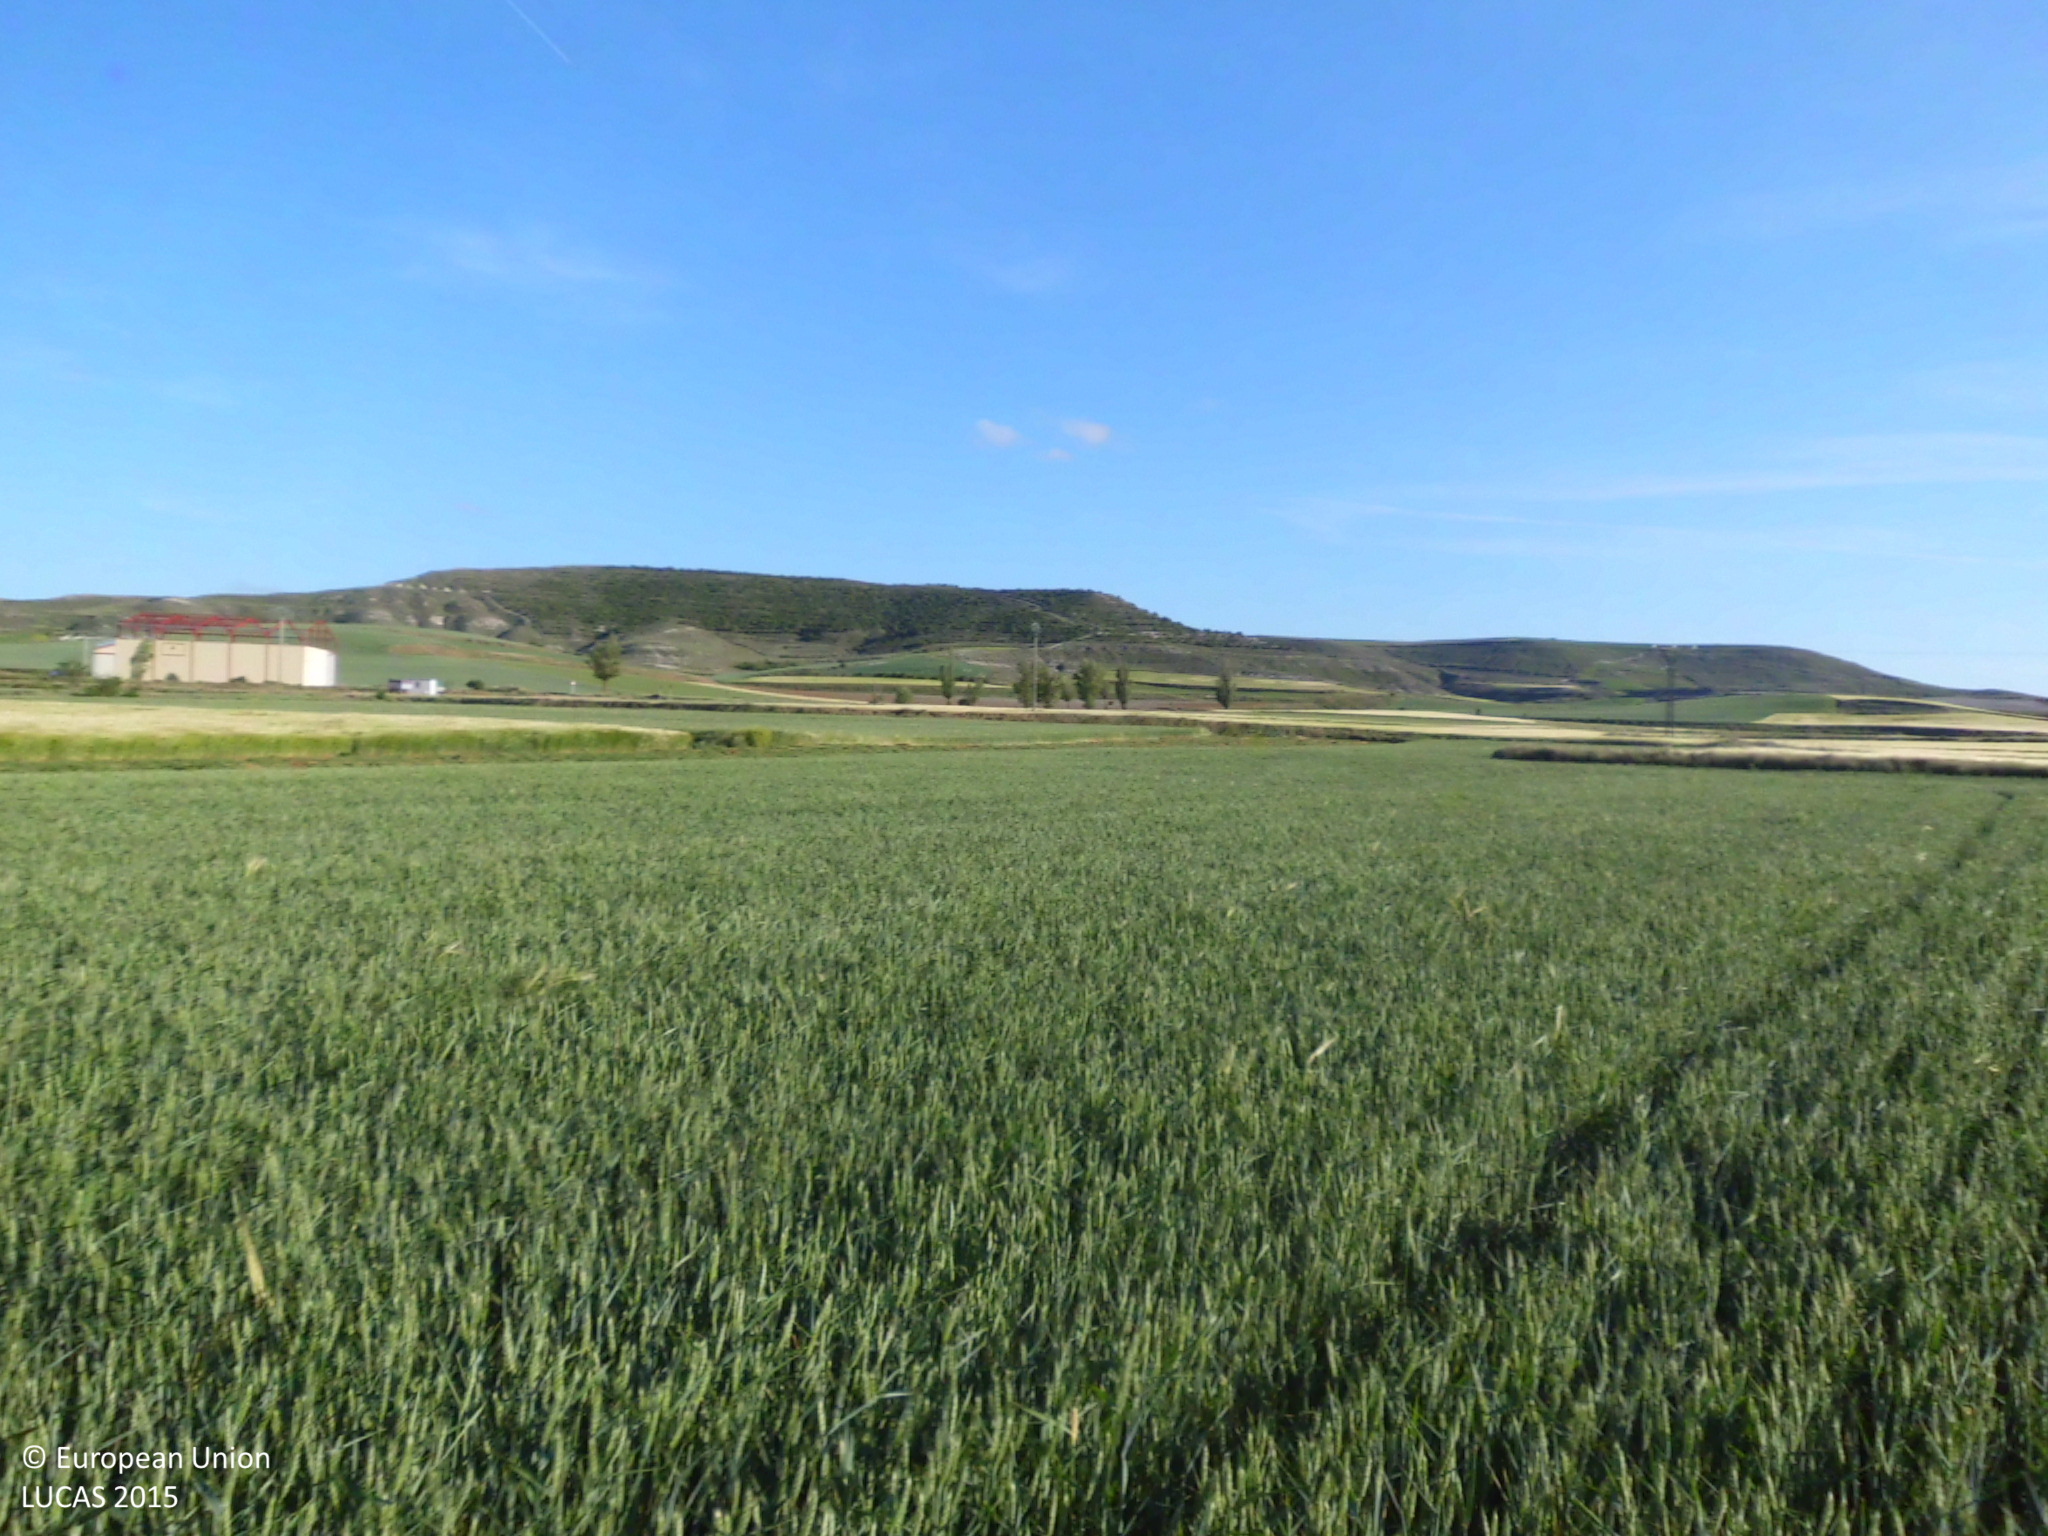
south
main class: Cropland
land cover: Common wheat
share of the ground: > 75 %
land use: Agriculture (excluding fallow land and kitchen gardens)
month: May
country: ES
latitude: 42.3101
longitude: -4.1771
